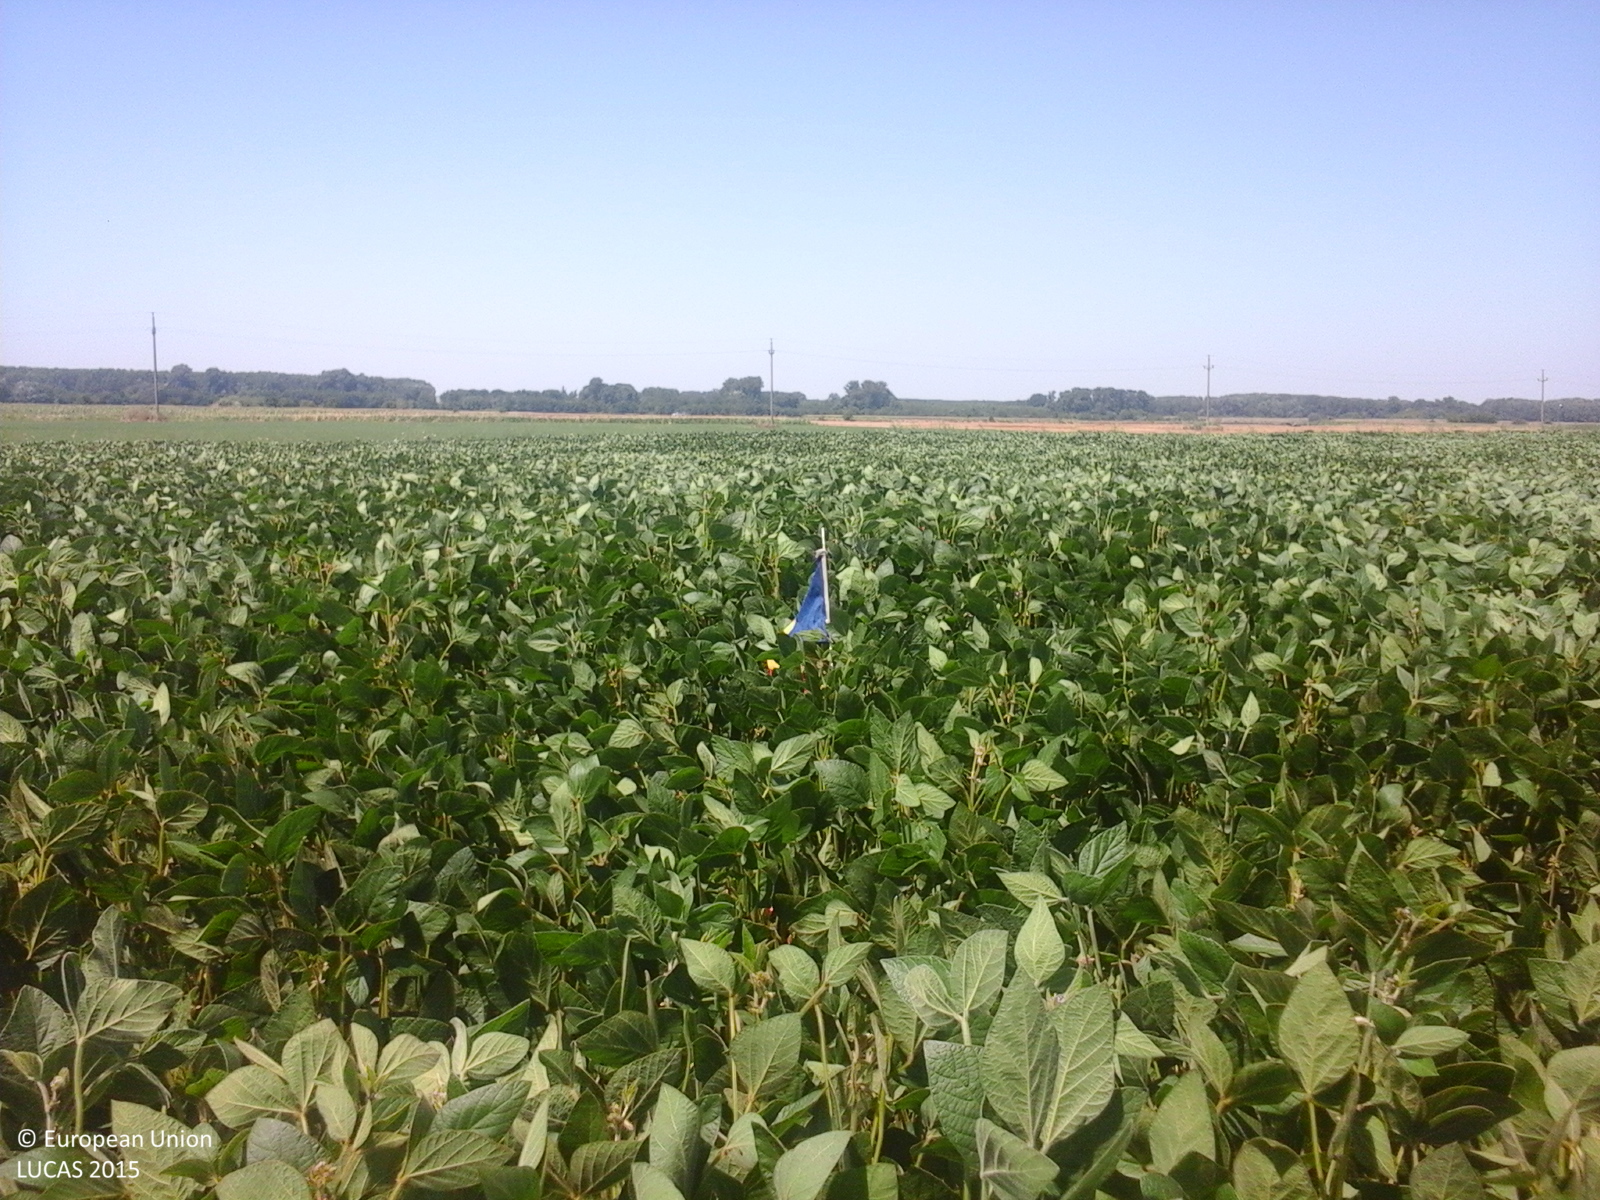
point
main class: Cropland
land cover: Soya
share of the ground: > 75 %
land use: Agriculture (excluding fallow land and kitchen gardens)
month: July
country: RO
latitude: 44.1805
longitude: 26.5887
